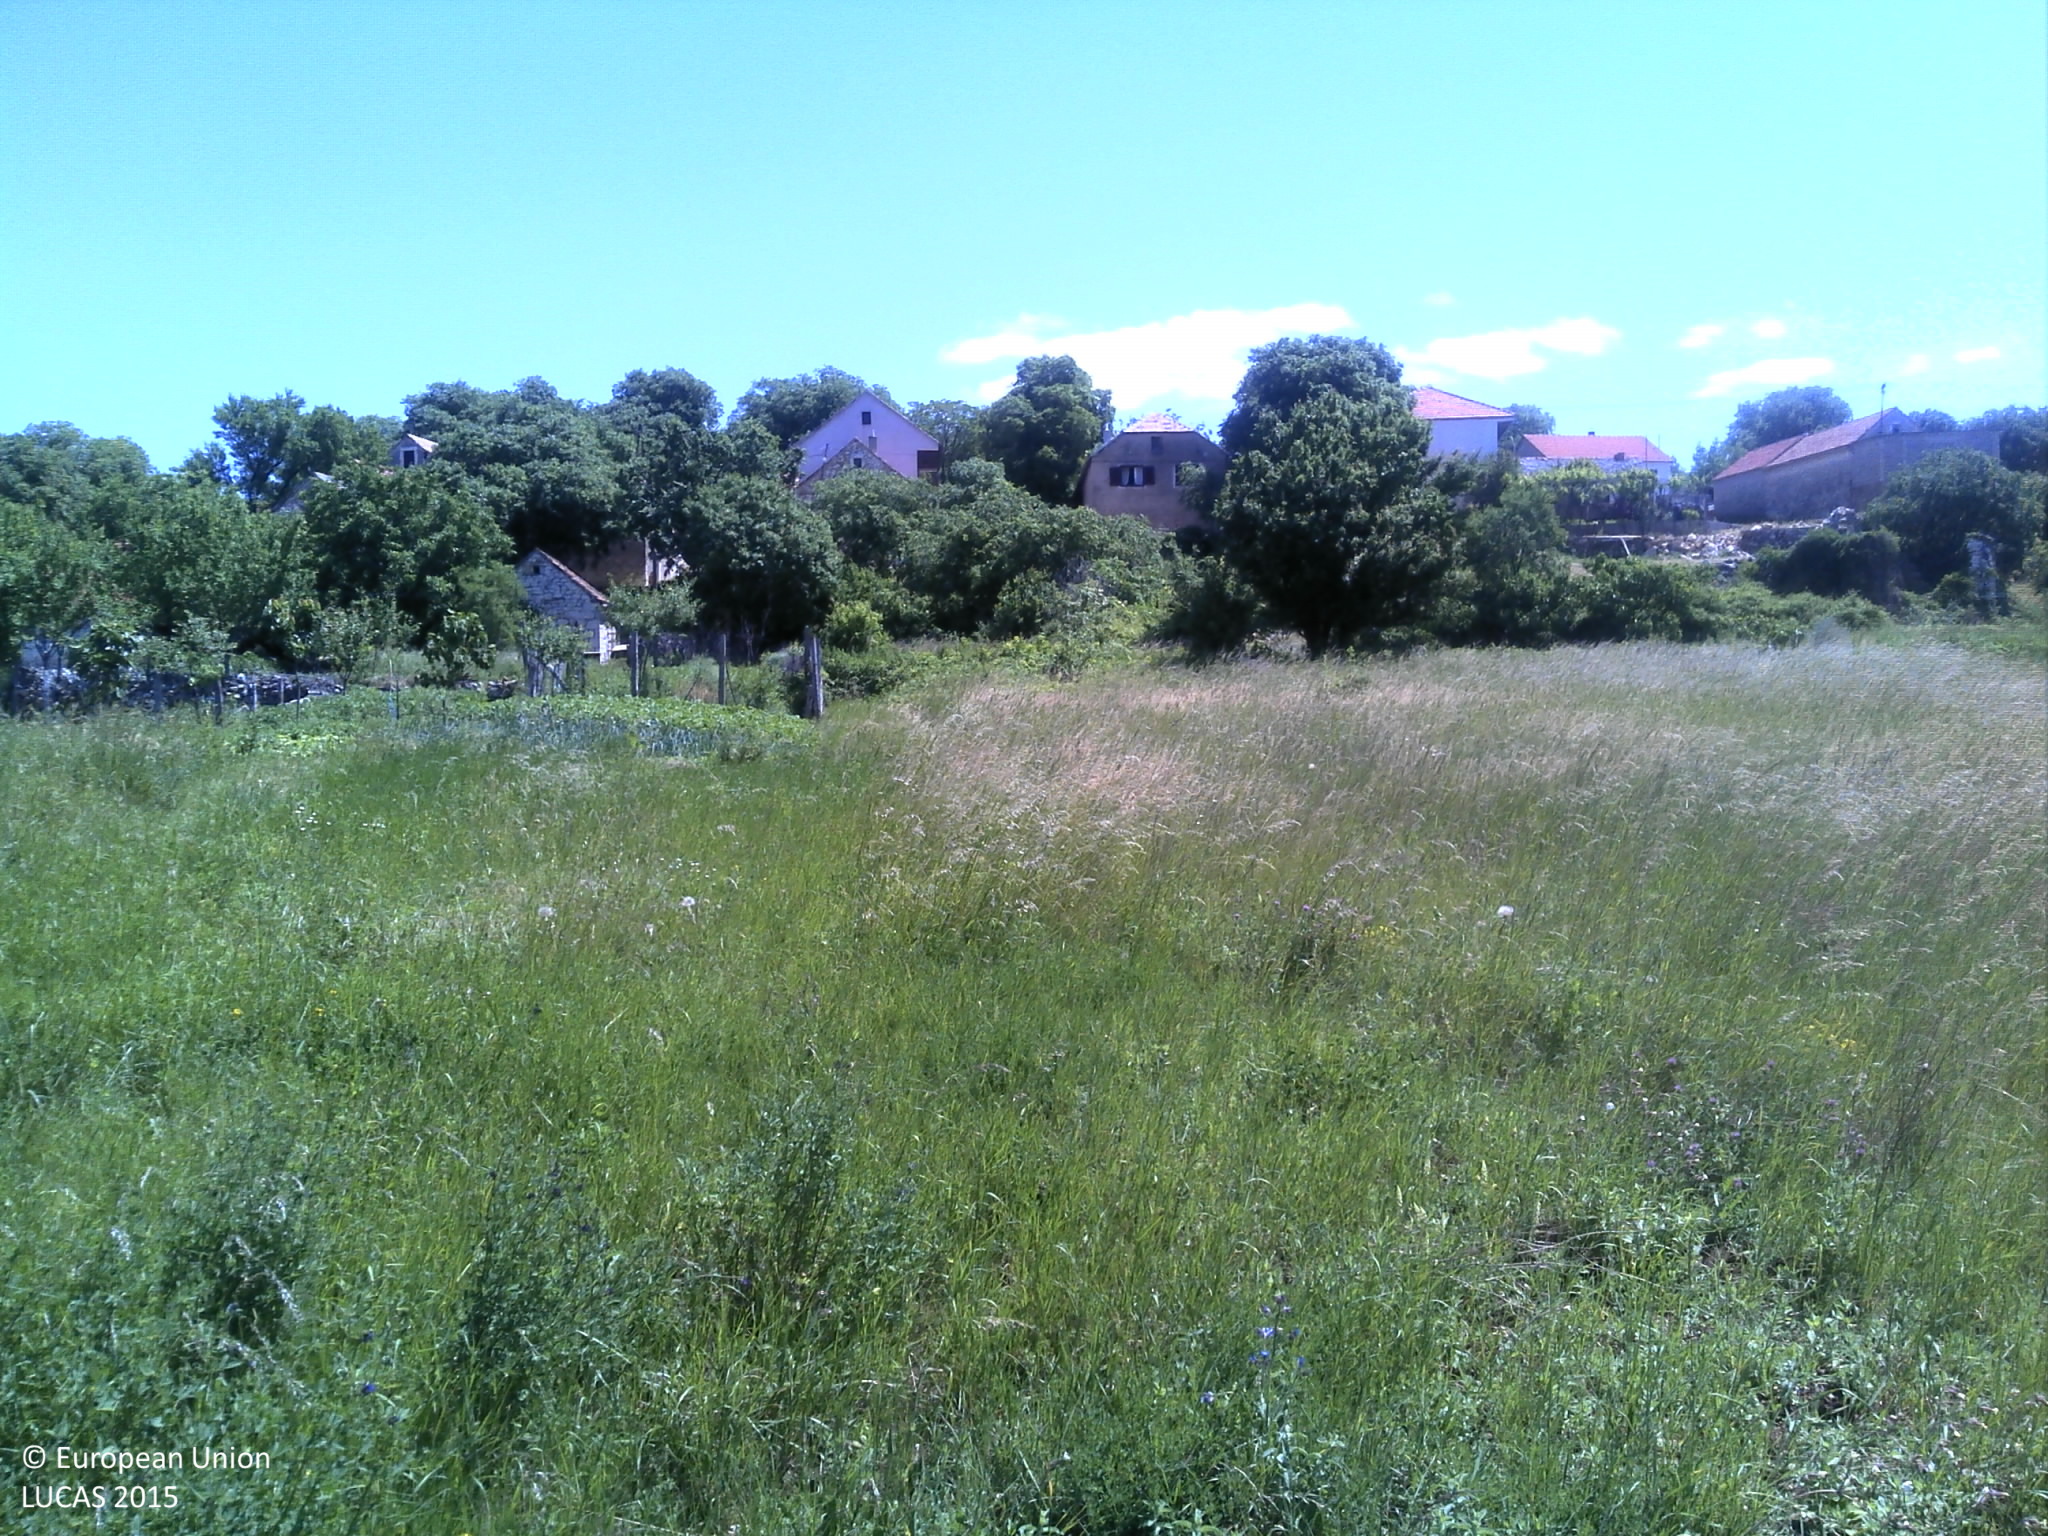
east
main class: Grassland
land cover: Grassland without tree/shrub cover
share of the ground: > 75 %
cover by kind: herbaceous plants 100 %
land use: Agriculture (excluding fallow land and kitchen gardens)
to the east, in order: Grassland without tree/shrub cover; Grassland with sparse tree/shrub cover; Grassland without tree/shrub cover; Dry stone walls; Artificial constructions in urban areas; Shrubland with sparse tree cover; Dry stone walls; Shrubland with sparse tree cover; Grassland with sparse tree/shrub cover
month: May
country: HR
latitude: 43.8921
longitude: 16.2286
